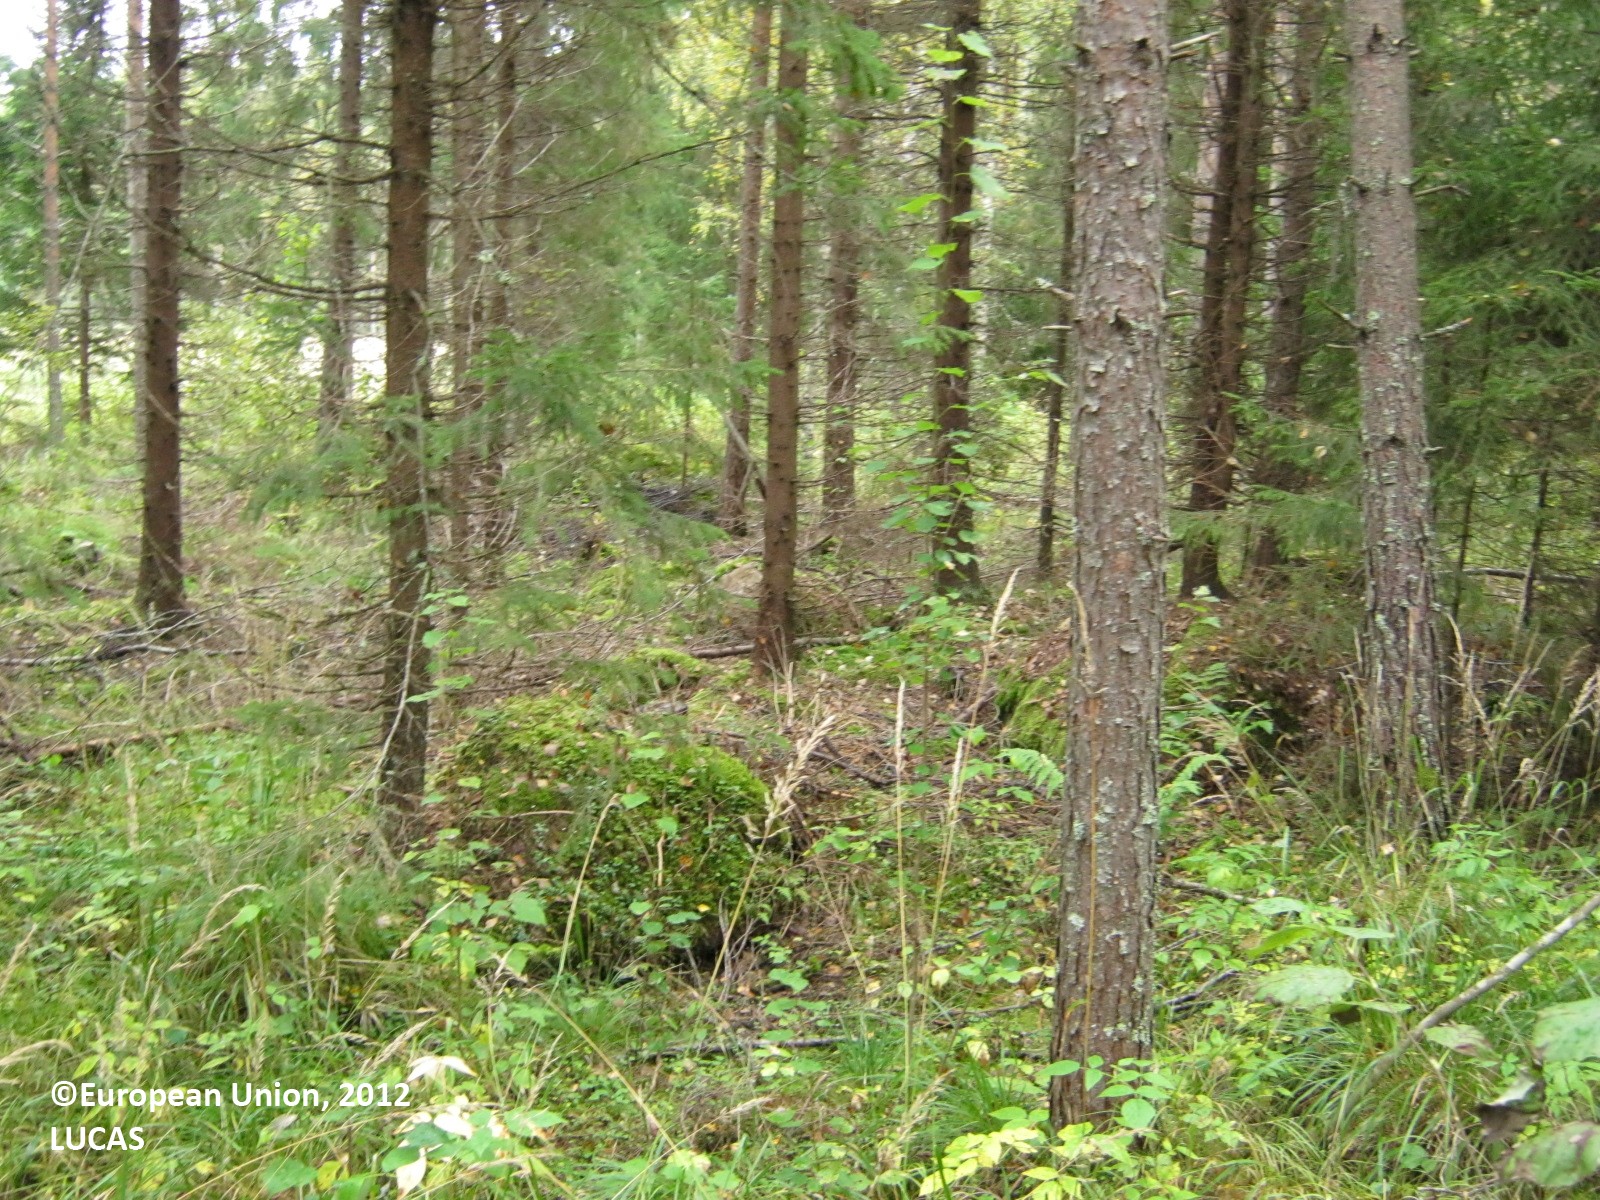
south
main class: Woodland
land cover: Other coniferous woodland
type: boreal forest
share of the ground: 50 - 75 %
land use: Forestry
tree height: > 5 m
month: September
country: FI
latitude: 60.8154
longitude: 27.6350
